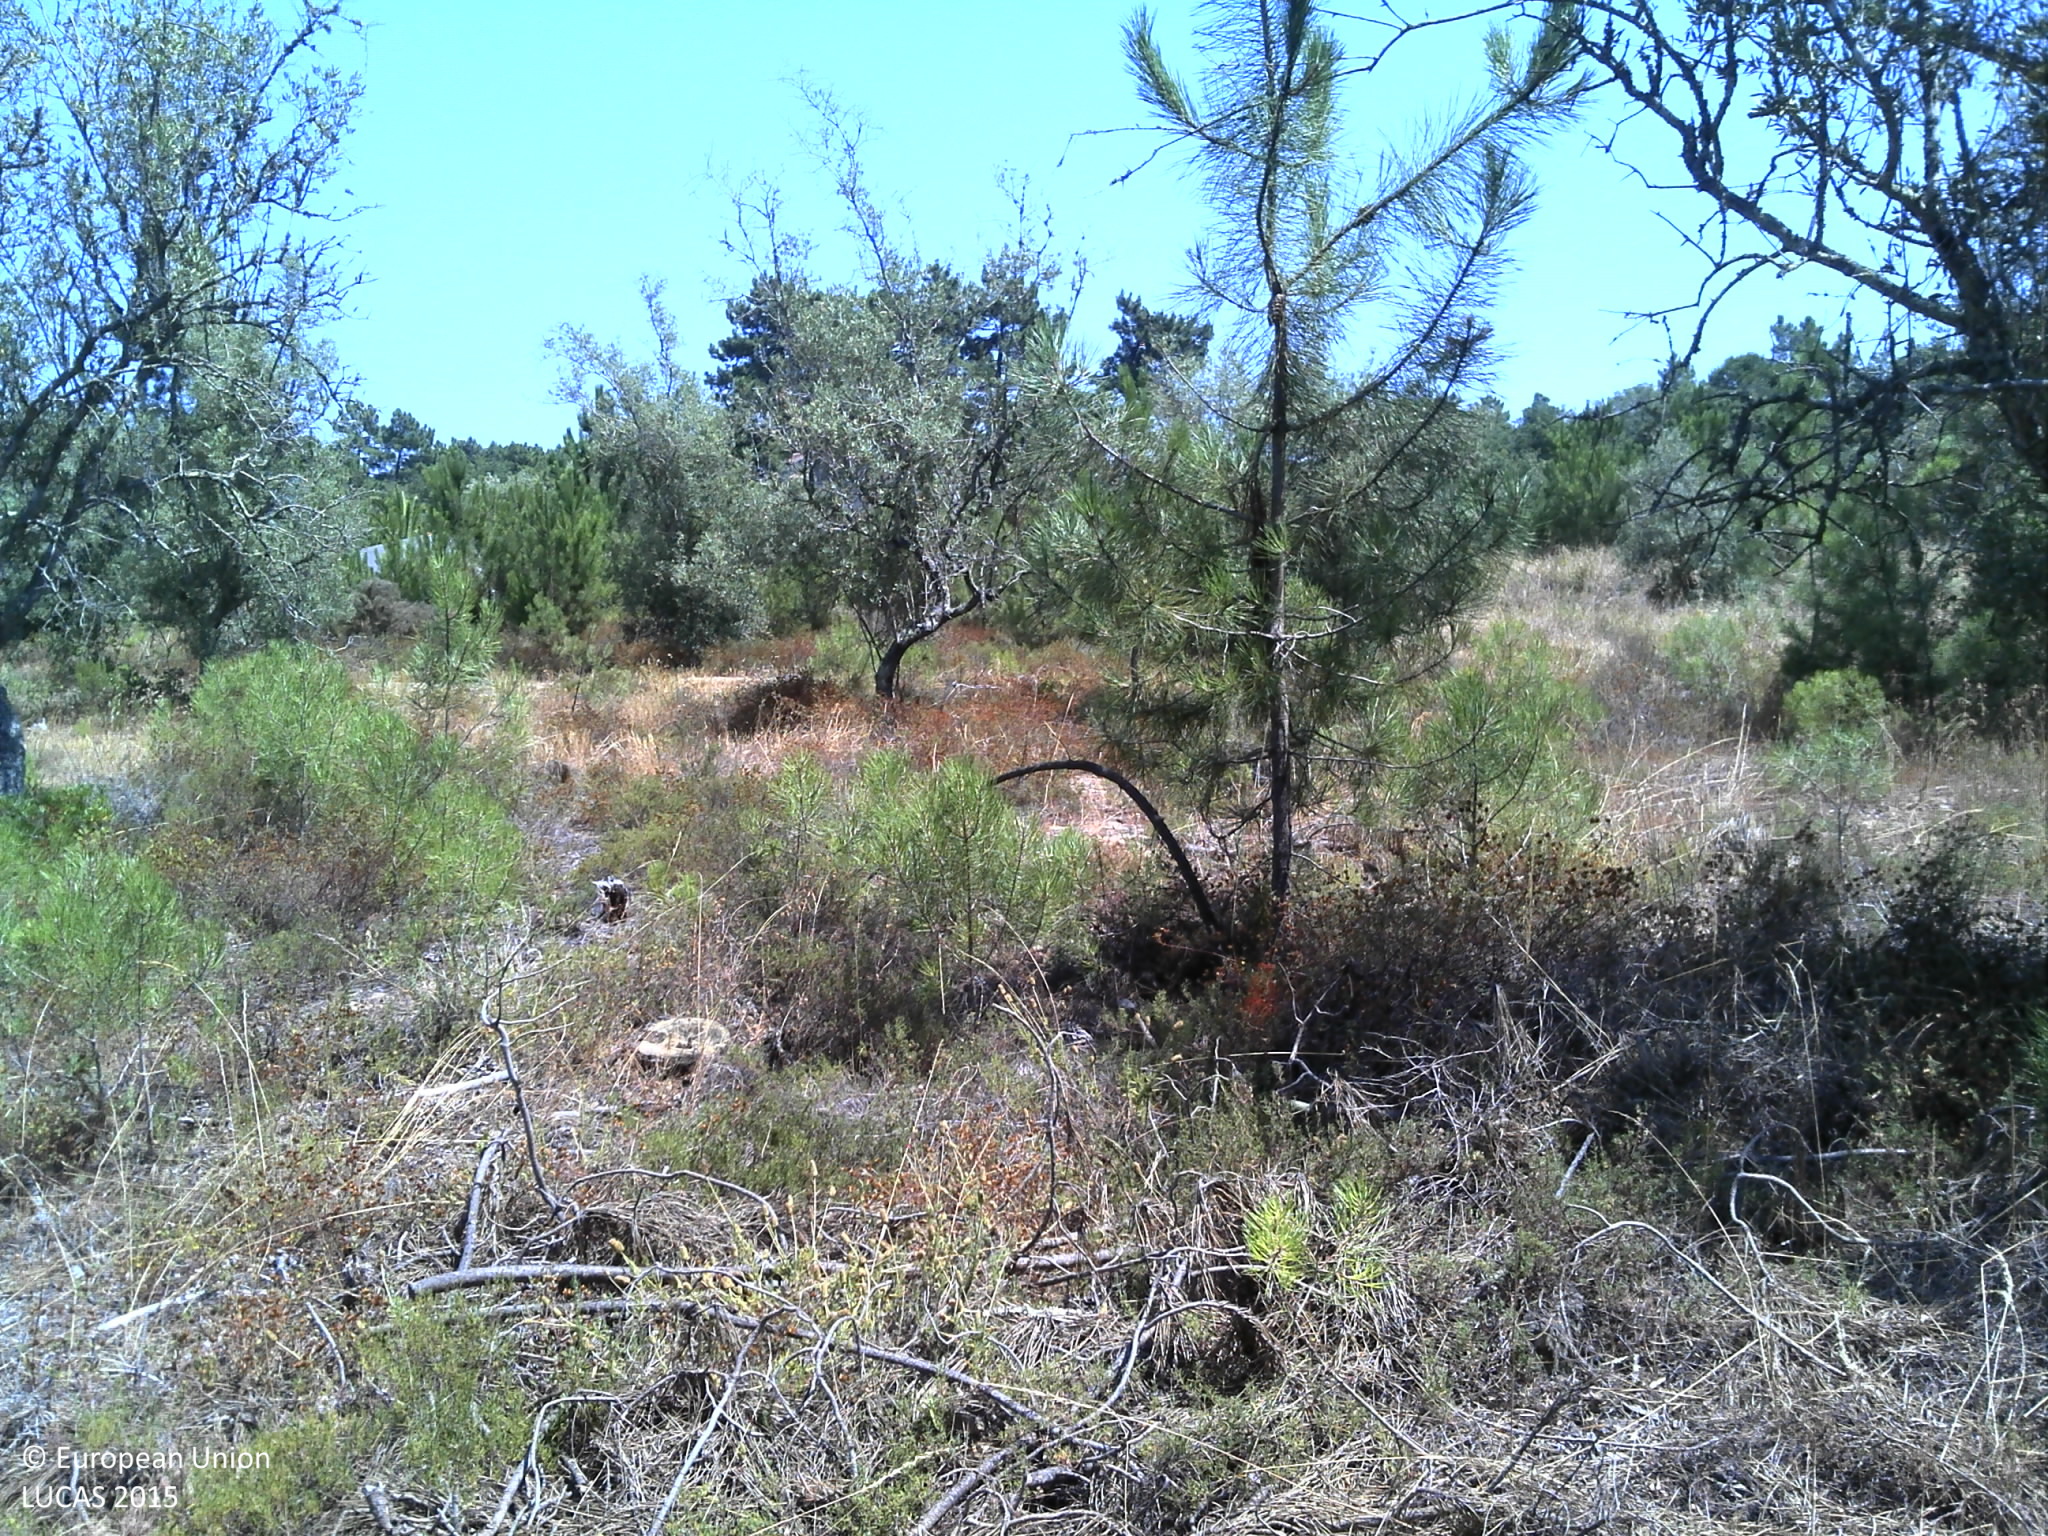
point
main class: Woodland
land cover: Pine dominated coniferous woodland
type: coniferous forest of the mediterranean region
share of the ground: 25 - 50 %
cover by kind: coniferous forest trees 35 %, unconsolidated bare surface 30 %, shrubs 15 %, herbaceous plants 15 %, broadleaved forest trees 5 %
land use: Forestry
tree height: > 5 m
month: June
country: PT
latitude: 38.4892
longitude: -9.0652
